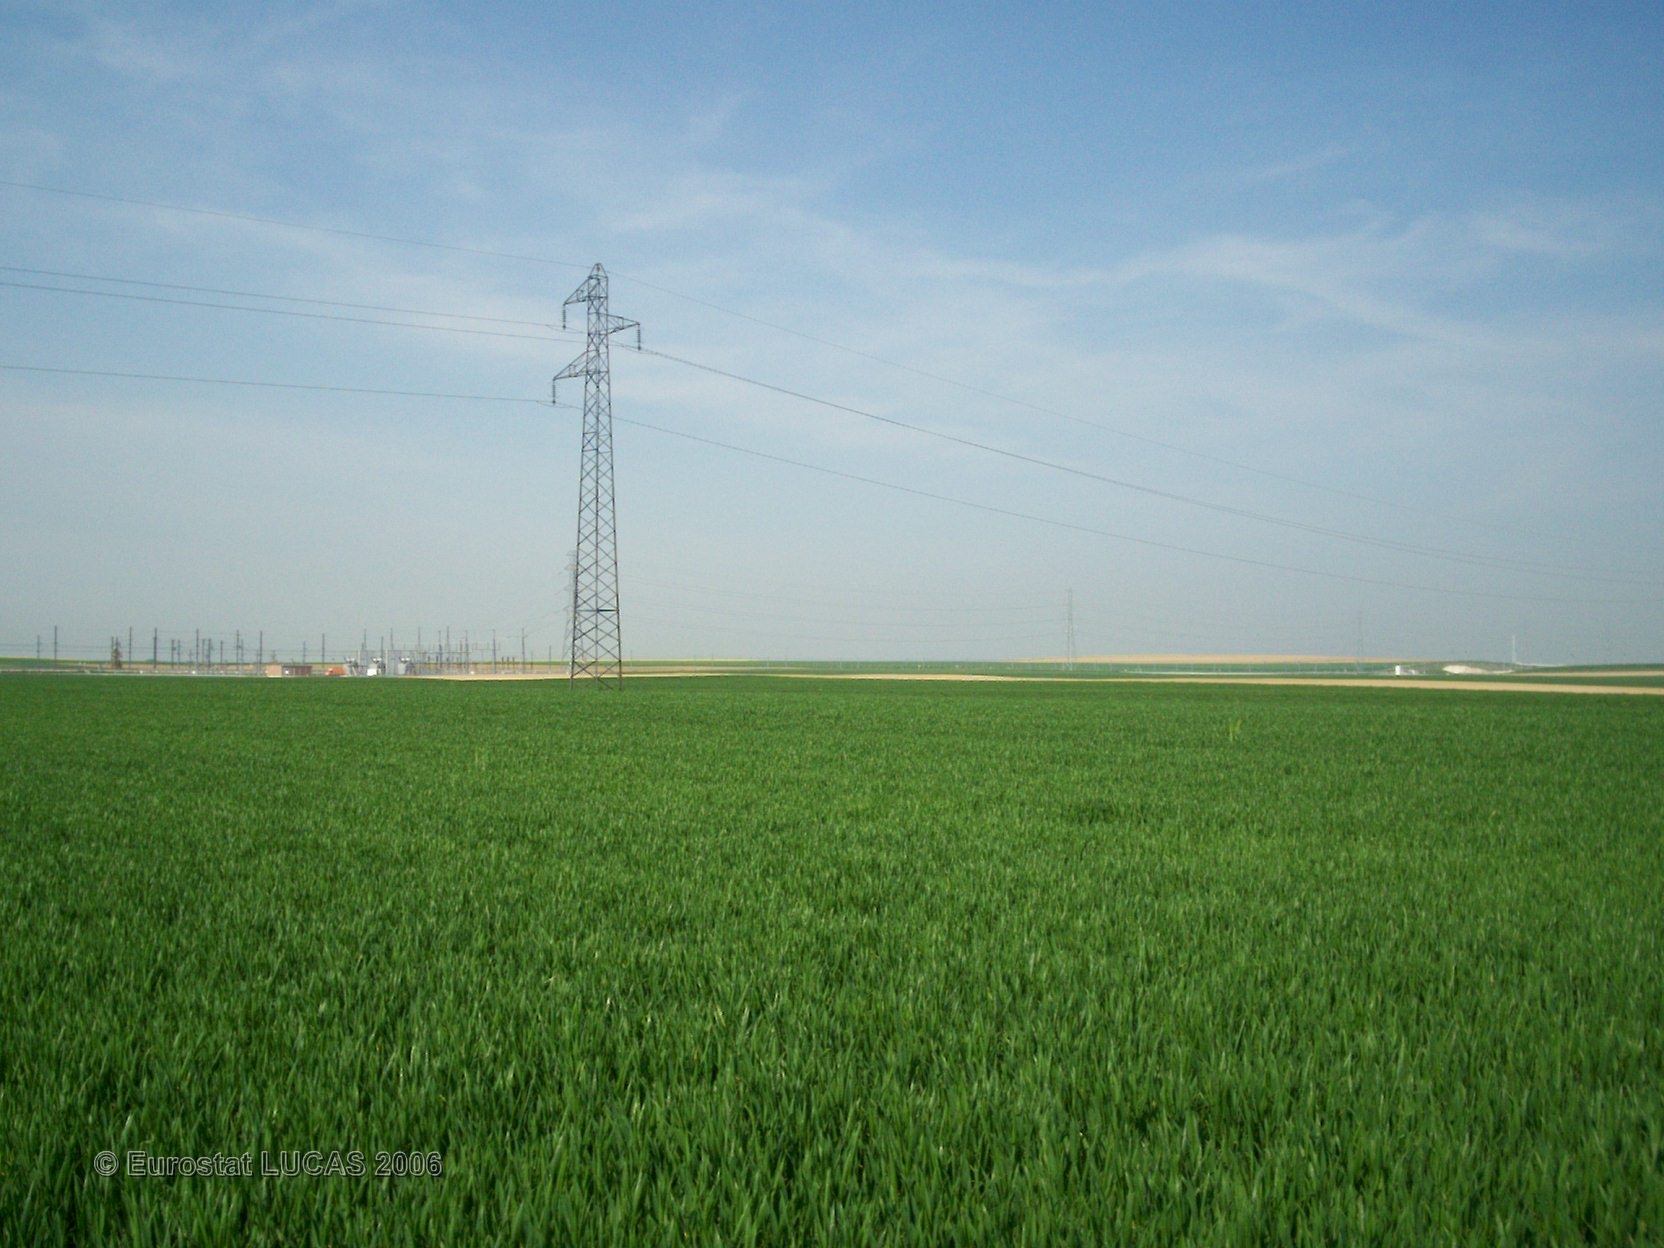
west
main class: Cropland
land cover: Common wheat
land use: Agriculture (excluding fallow land and kitchen gardens)
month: May
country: FR
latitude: 49.0564
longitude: 4.4269
